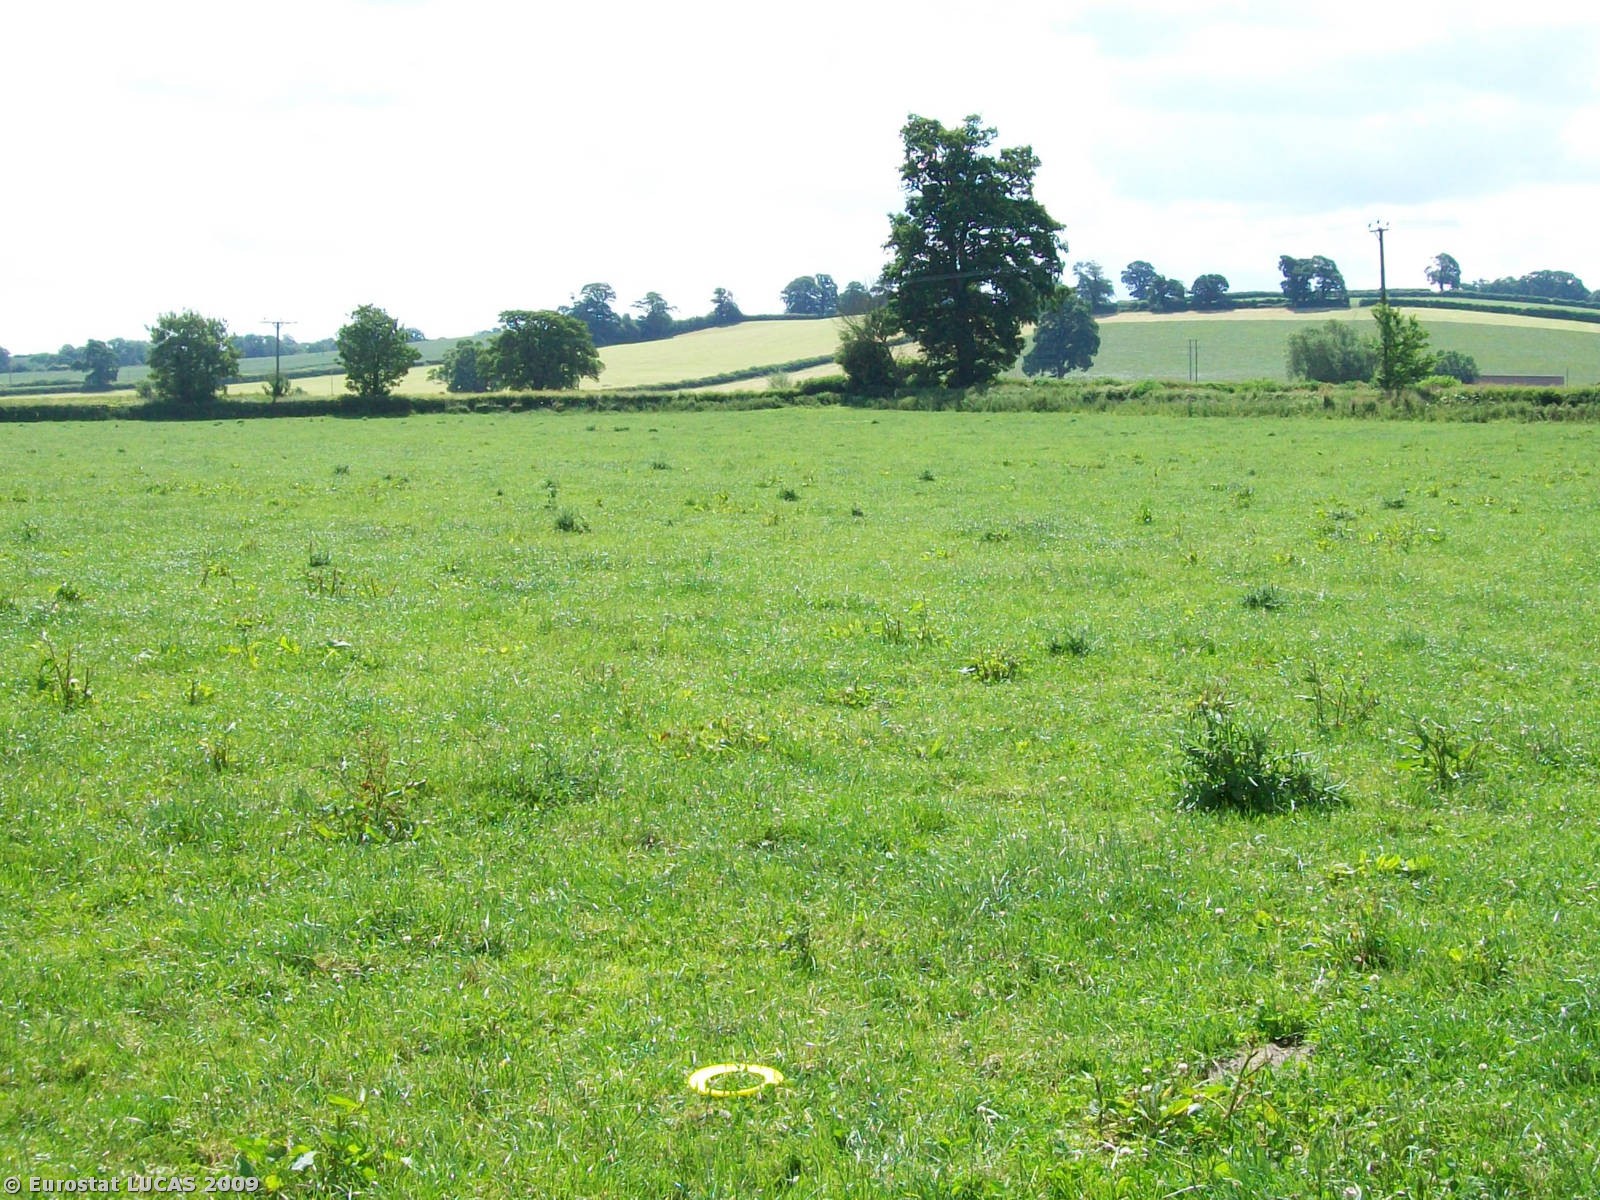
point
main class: Grassland
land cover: Grassland without tree/shrub cover
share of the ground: > 75 %
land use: Agriculture (excluding fallow land and kitchen gardens)
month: June
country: GB
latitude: 50.9698
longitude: -2.6430
